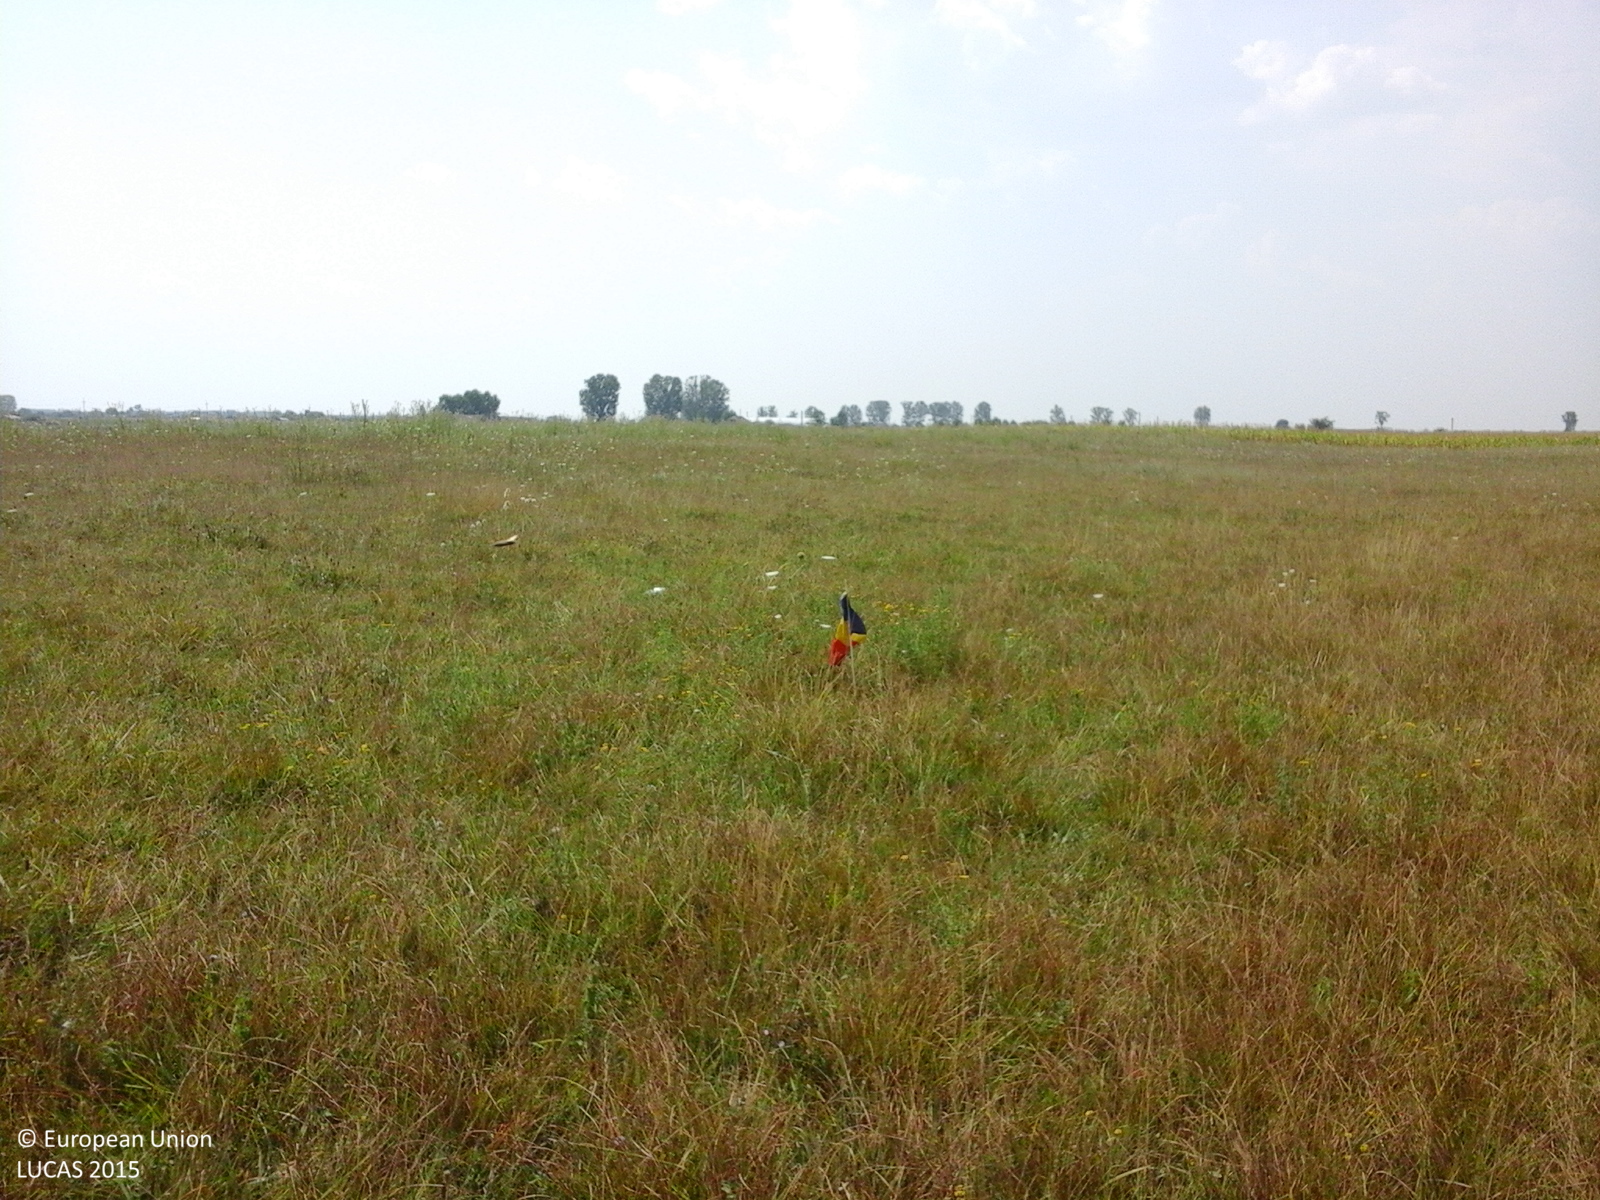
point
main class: Grassland
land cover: Grassland without tree/shrub cover
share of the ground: > 75 %
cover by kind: herbaceous plants 100 %
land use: Agriculture (excluding fallow land and kitchen gardens)
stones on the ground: < 10 %
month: August
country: RO
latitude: 43.9074
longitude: 23.1797
